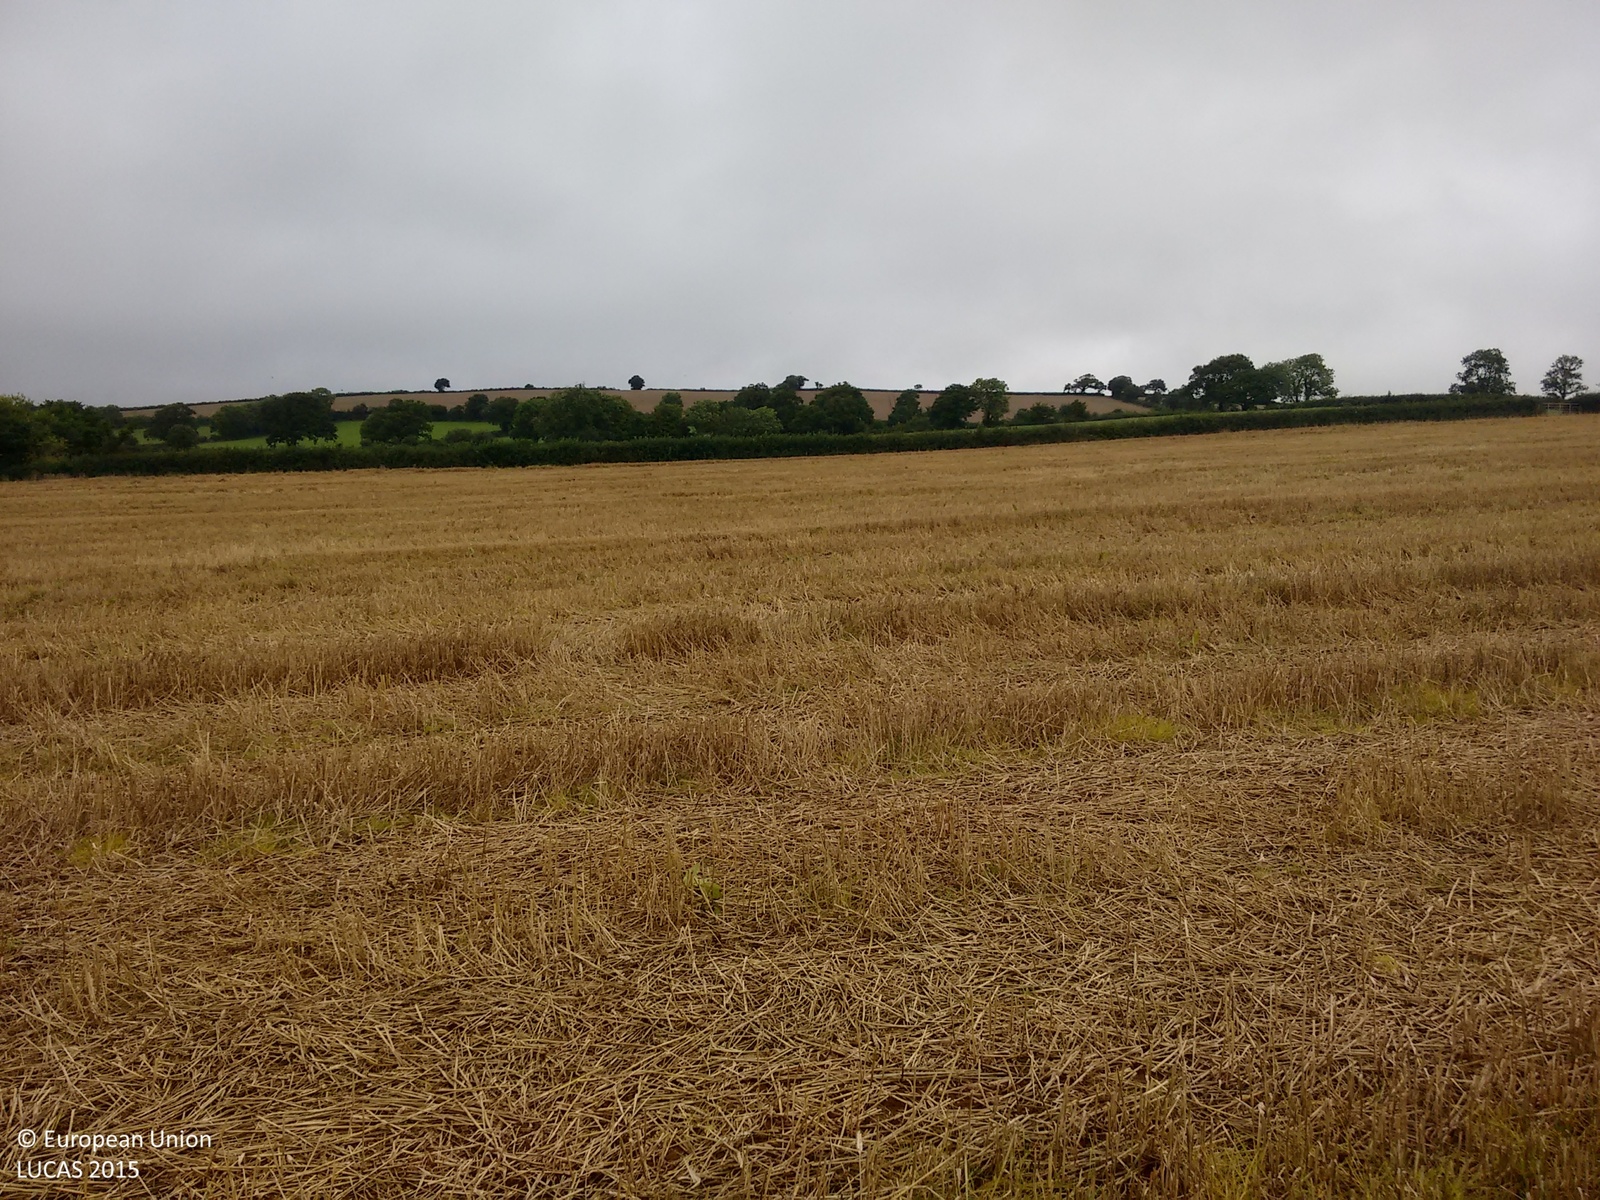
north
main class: Cropland
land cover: Barley
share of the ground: > 75 %
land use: Agriculture (excluding fallow land and kitchen gardens)
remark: Harvested field
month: August
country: GB
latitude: 50.8606
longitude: -3.5969
